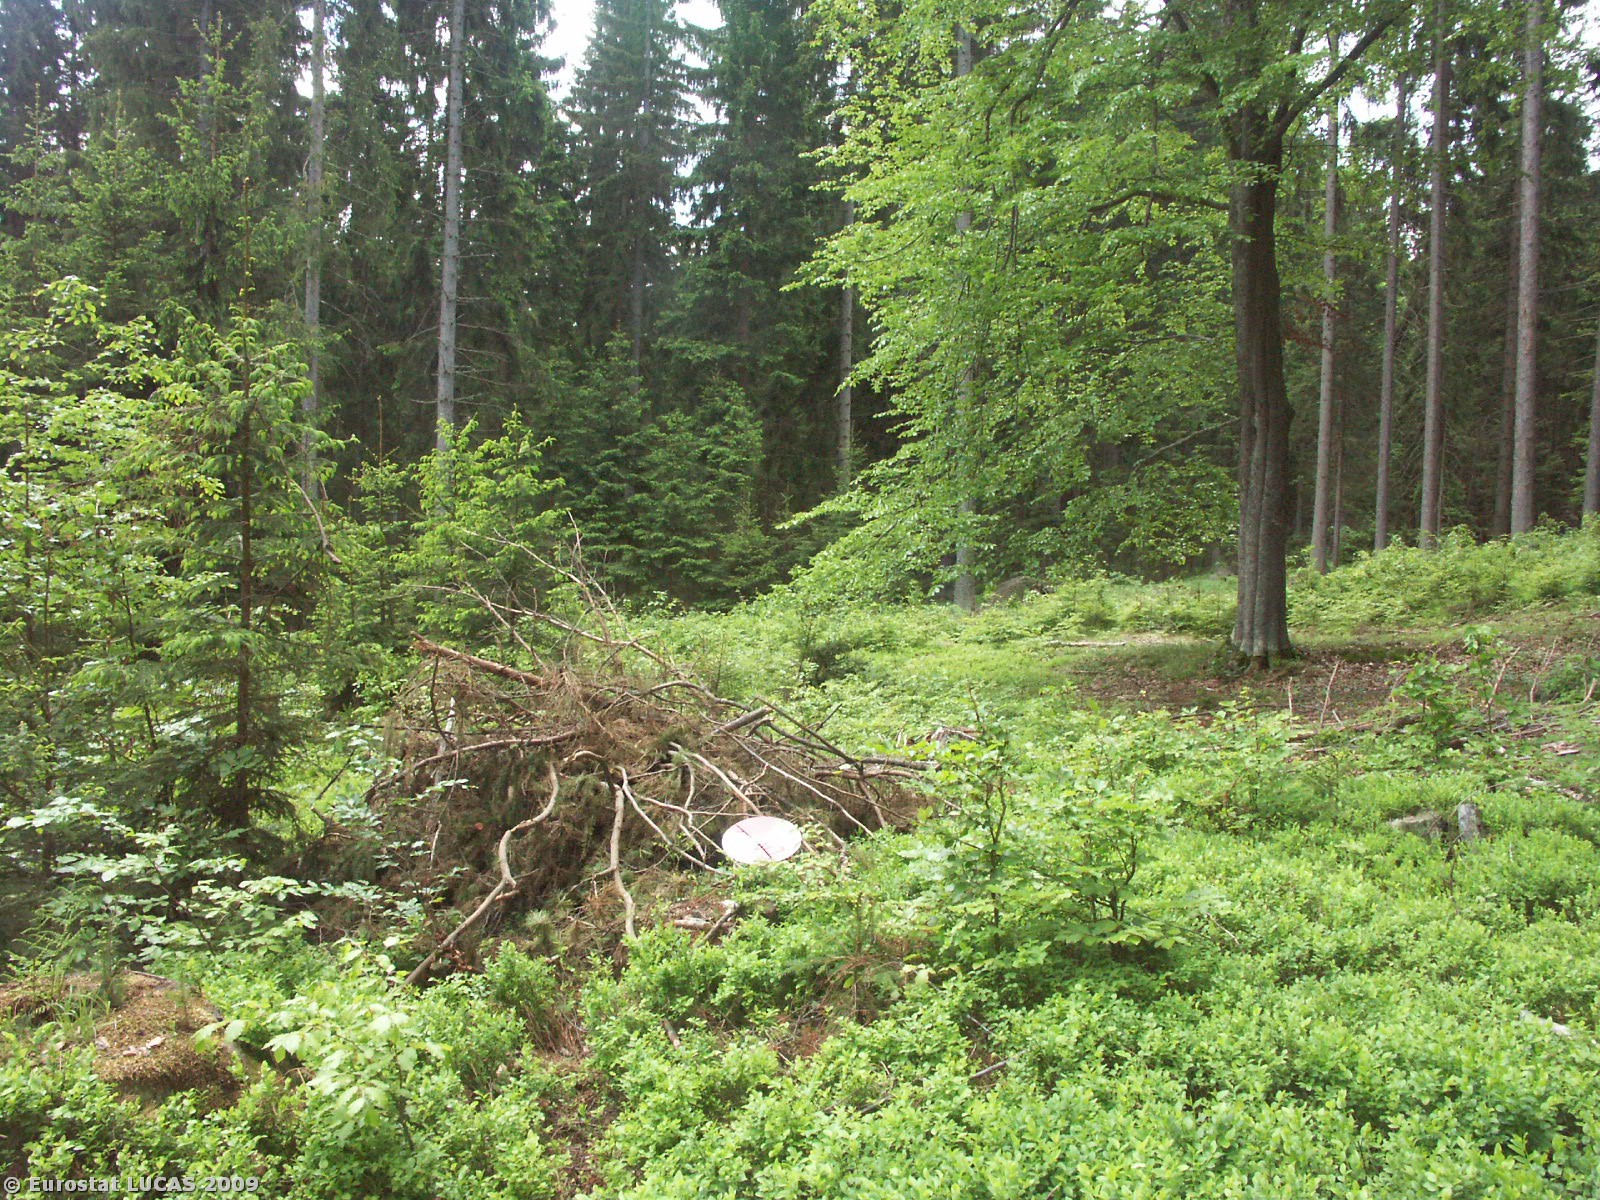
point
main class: Woodland
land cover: Mixed woodland
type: mountainous beech forest
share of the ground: > 75 %
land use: Forestry
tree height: > 5 m
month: May
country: CZ
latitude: 48.6838
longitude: 14.6601
